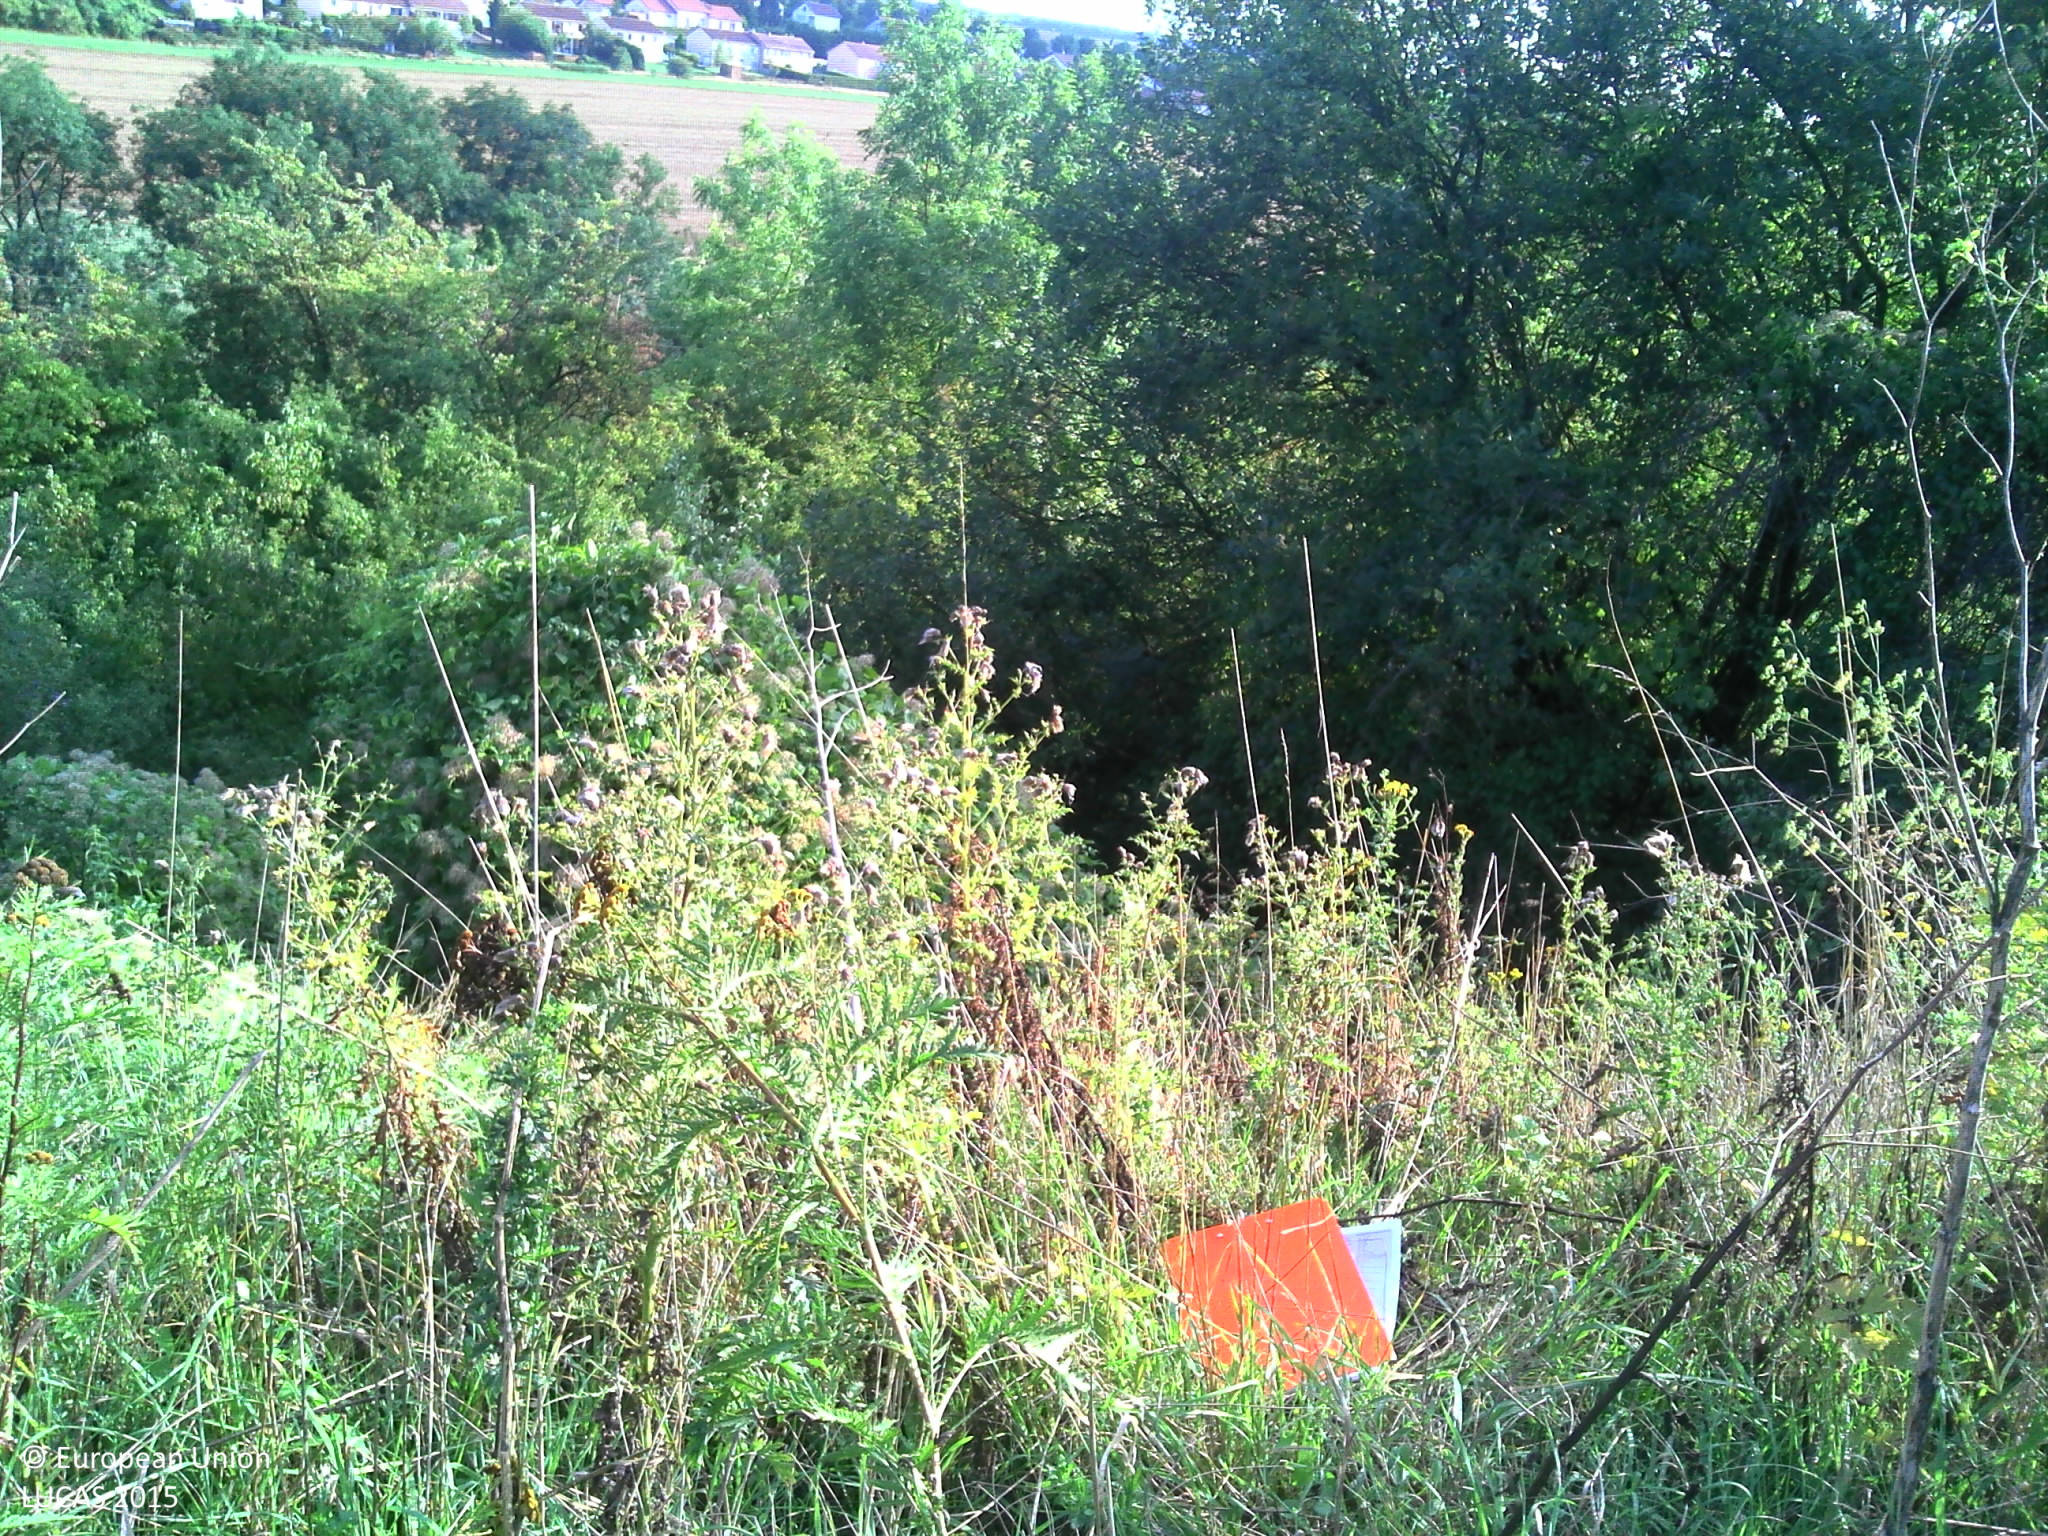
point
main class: Shrubland
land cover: Shrubland with sparse tree cover
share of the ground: > 75 %
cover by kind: shrubs 50 %, herbaceous plants 30 %, consolidated bare surface 15 %, broadleaved forest trees 5 %
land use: Semi-natural and natural areas not in use
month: September
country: FR
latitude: 49.2120
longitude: 5.9498
